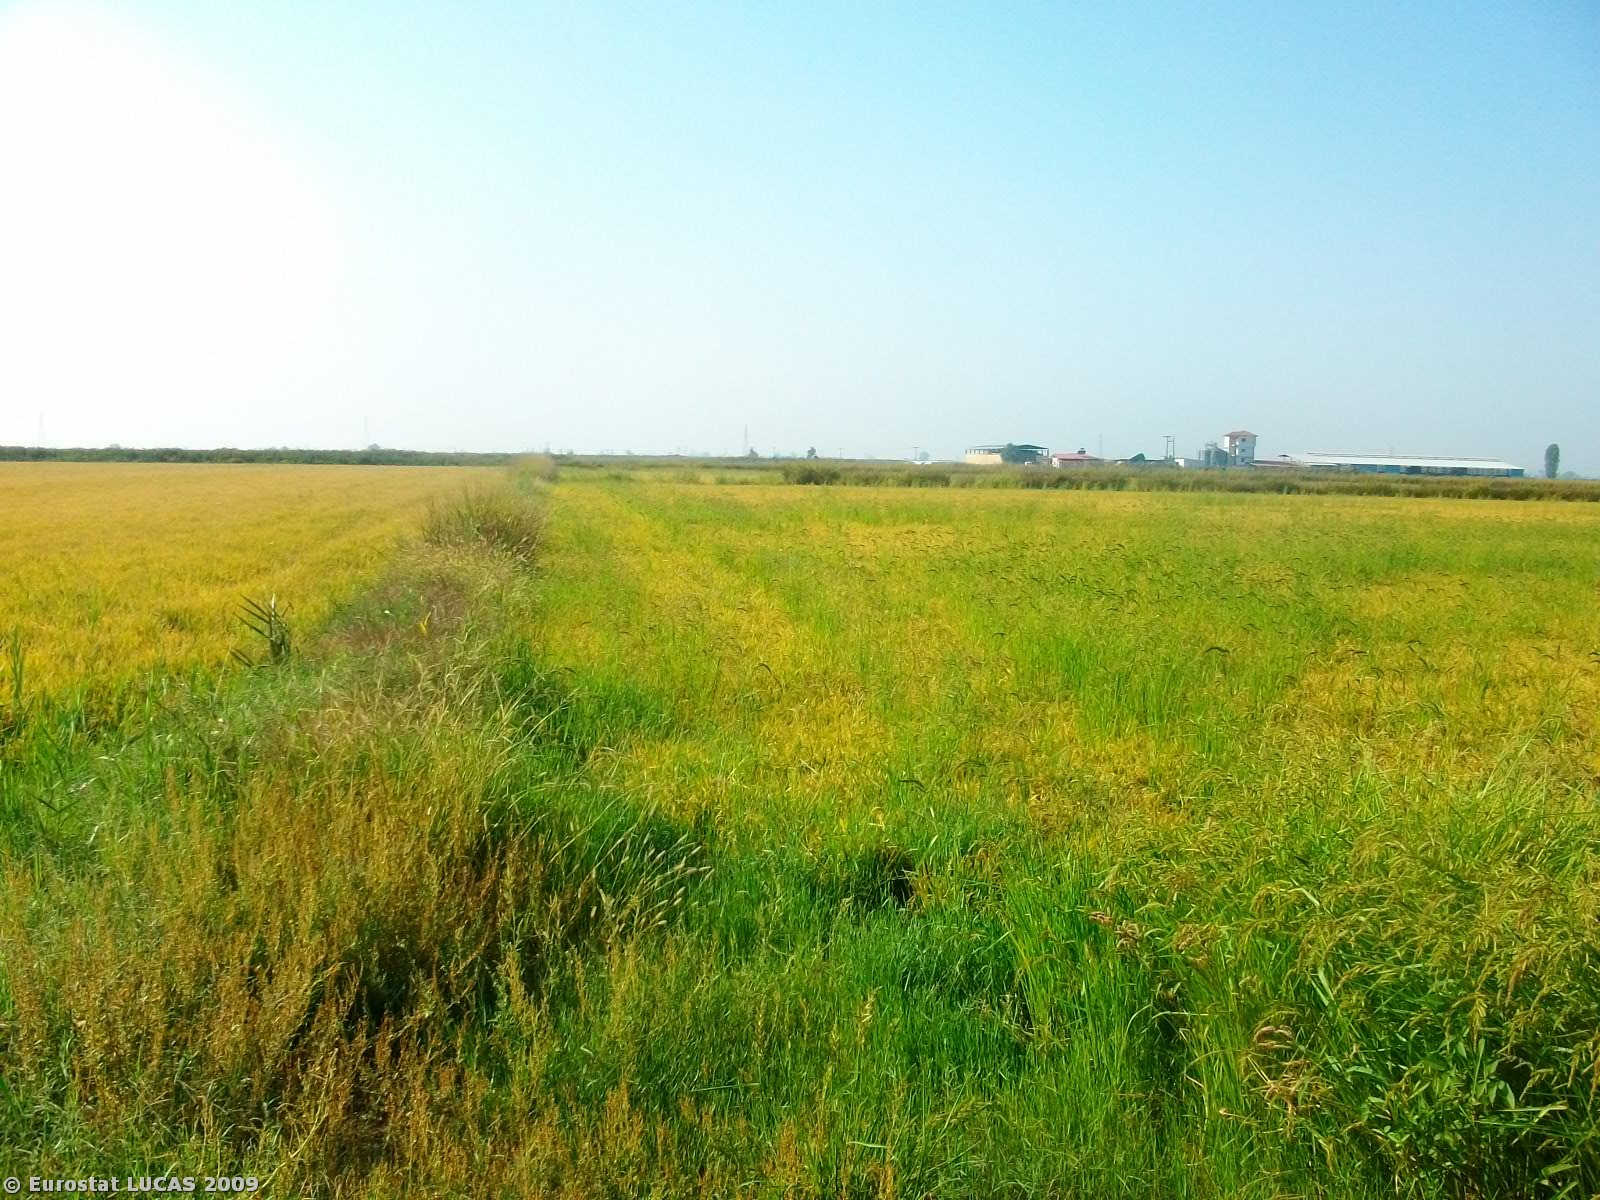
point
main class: Cropland
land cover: Rice
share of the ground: > 75 %
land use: Agriculture (excluding fallow land and kitchen gardens)
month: August
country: GR
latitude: 40.6935
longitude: 22.7507
